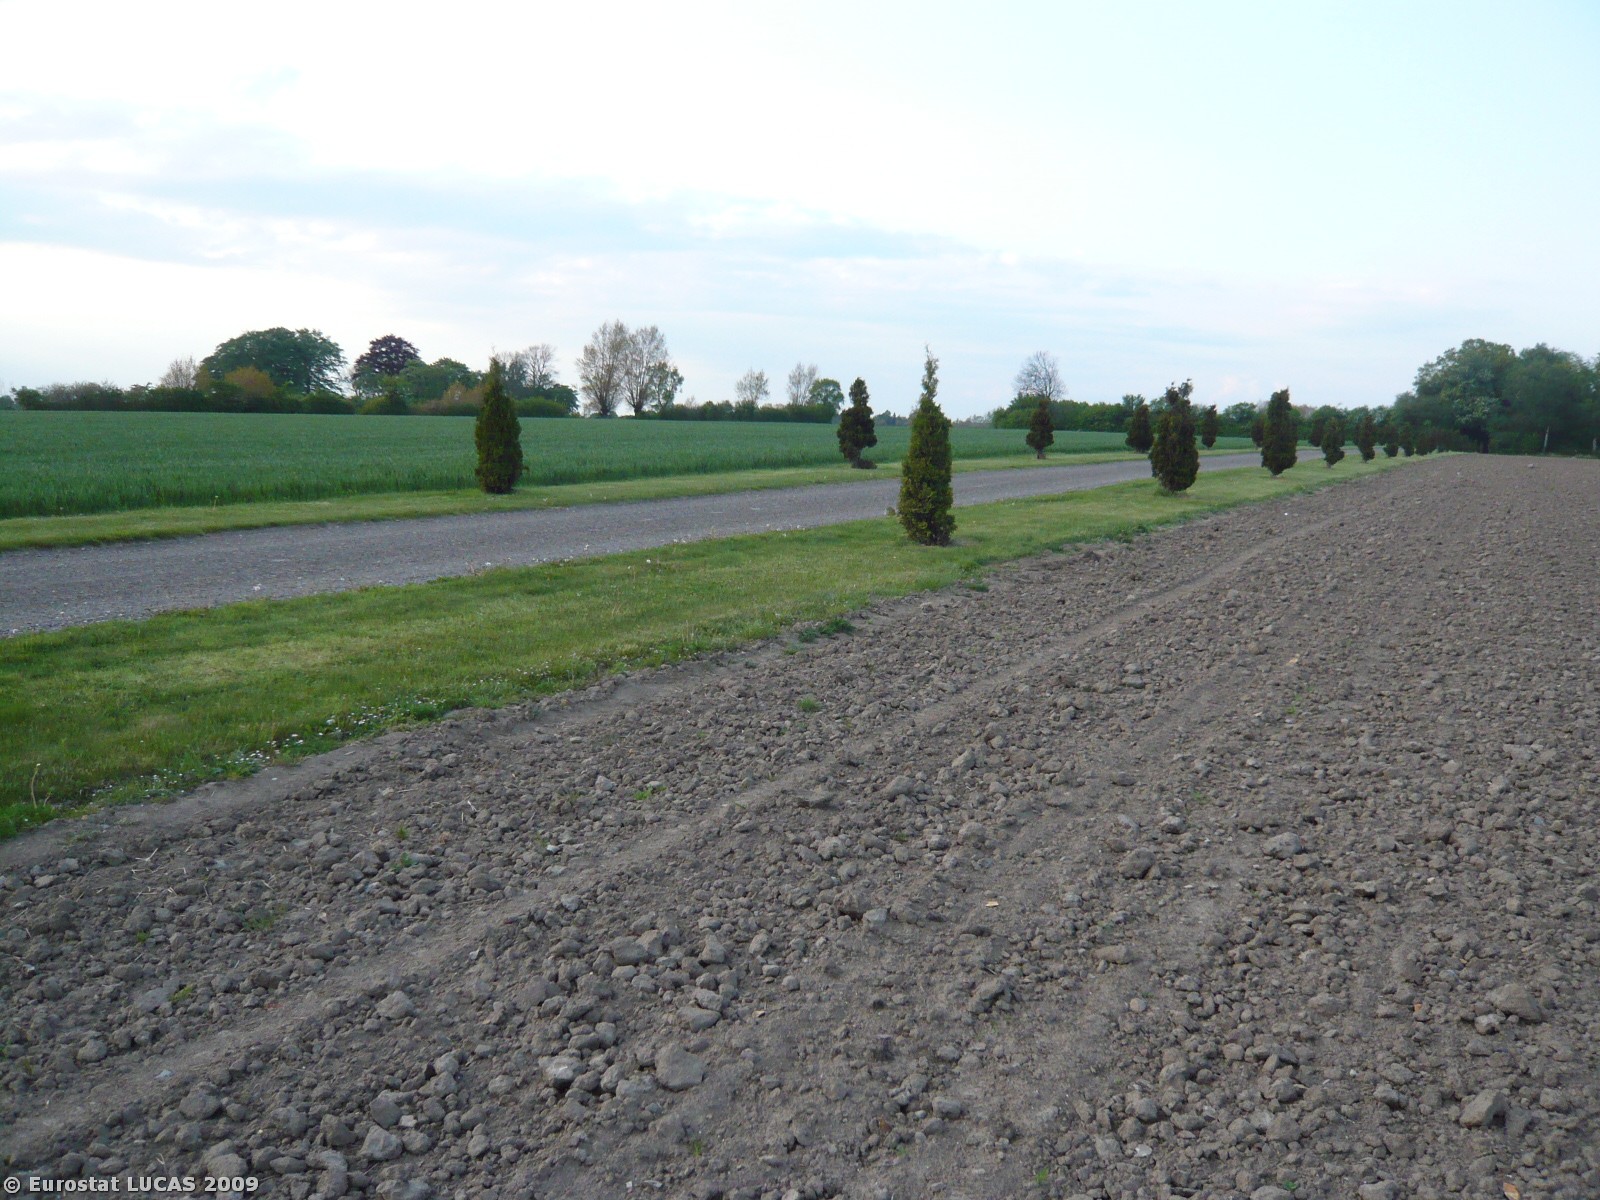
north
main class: Cropland
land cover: Other root crops
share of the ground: < 10 %
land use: Agriculture (excluding fallow land and kitchen gardens)
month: May
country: DK
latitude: 55.3223
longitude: 12.2835
